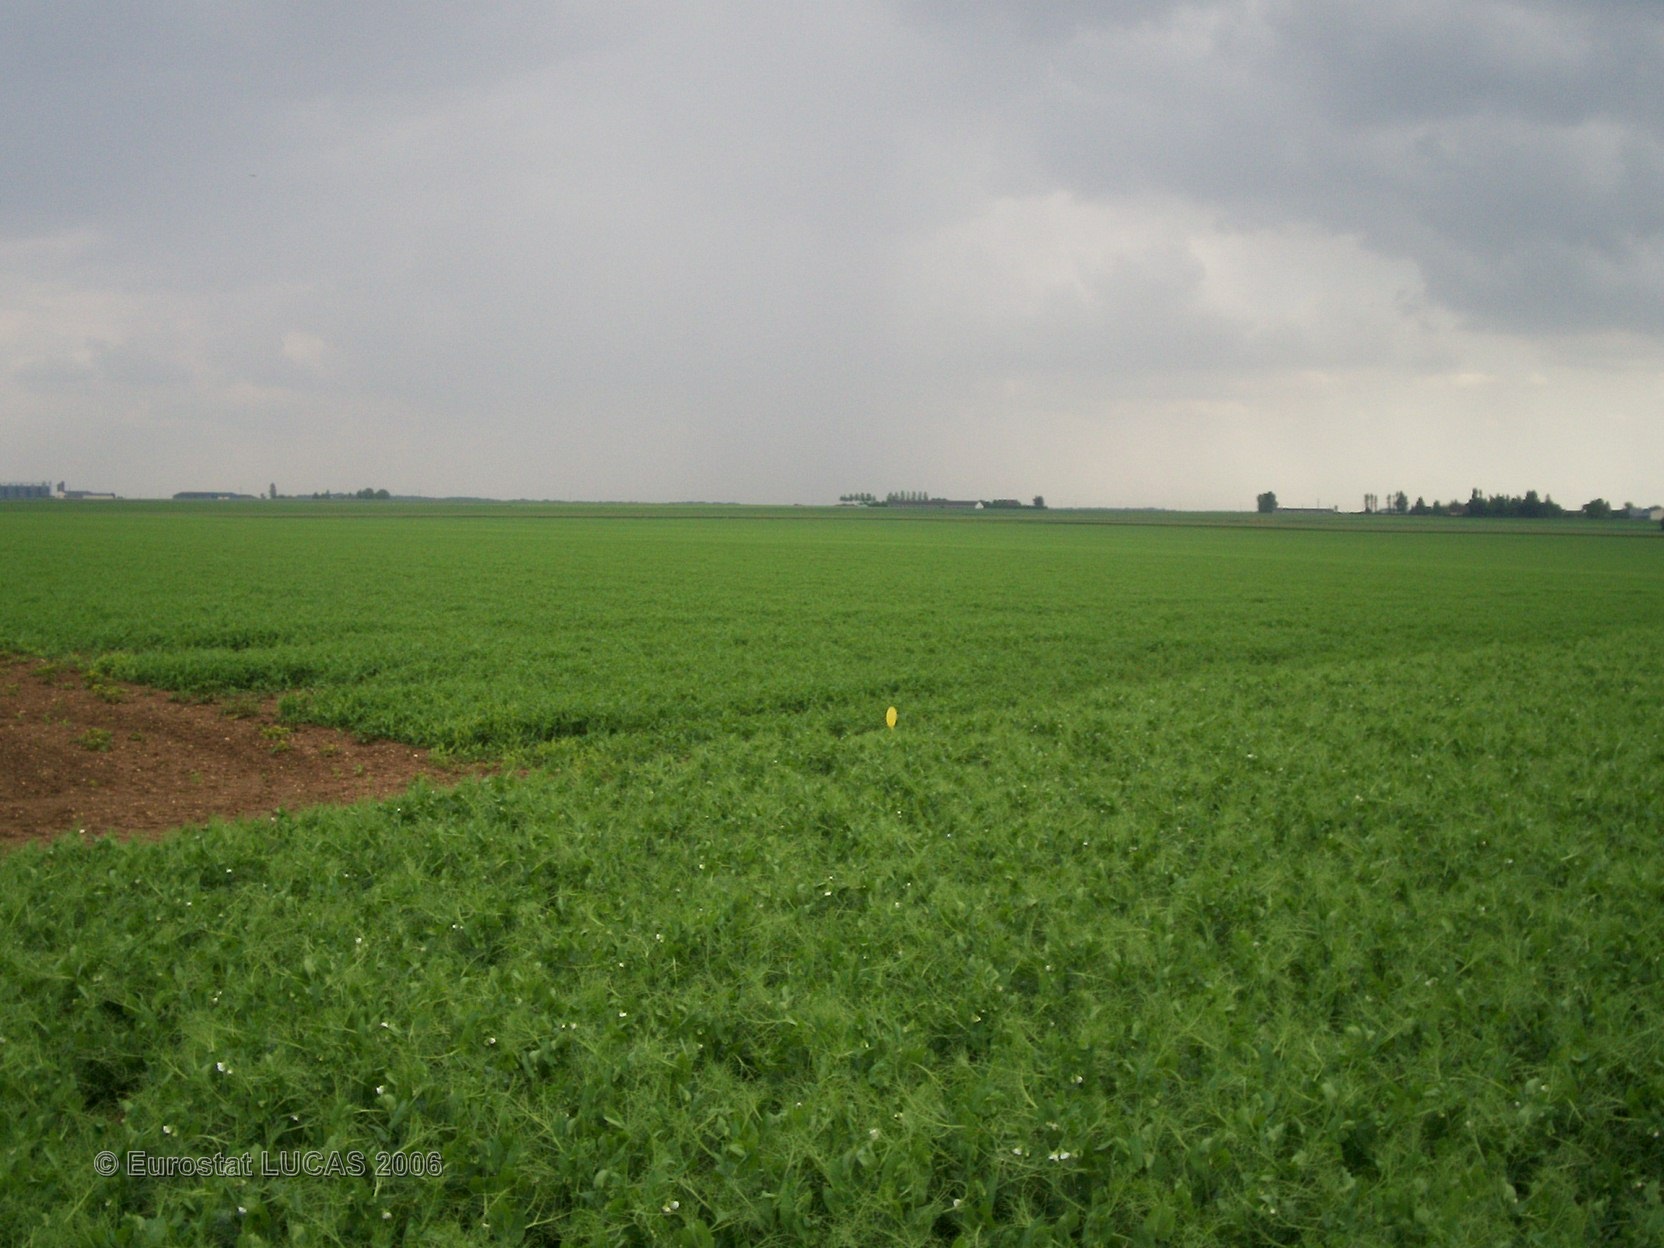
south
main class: Cropland
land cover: Dry pulses
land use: Agriculture (excluding fallow land and kitchen gardens)
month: June
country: FR
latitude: 49.7641
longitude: 2.6165
